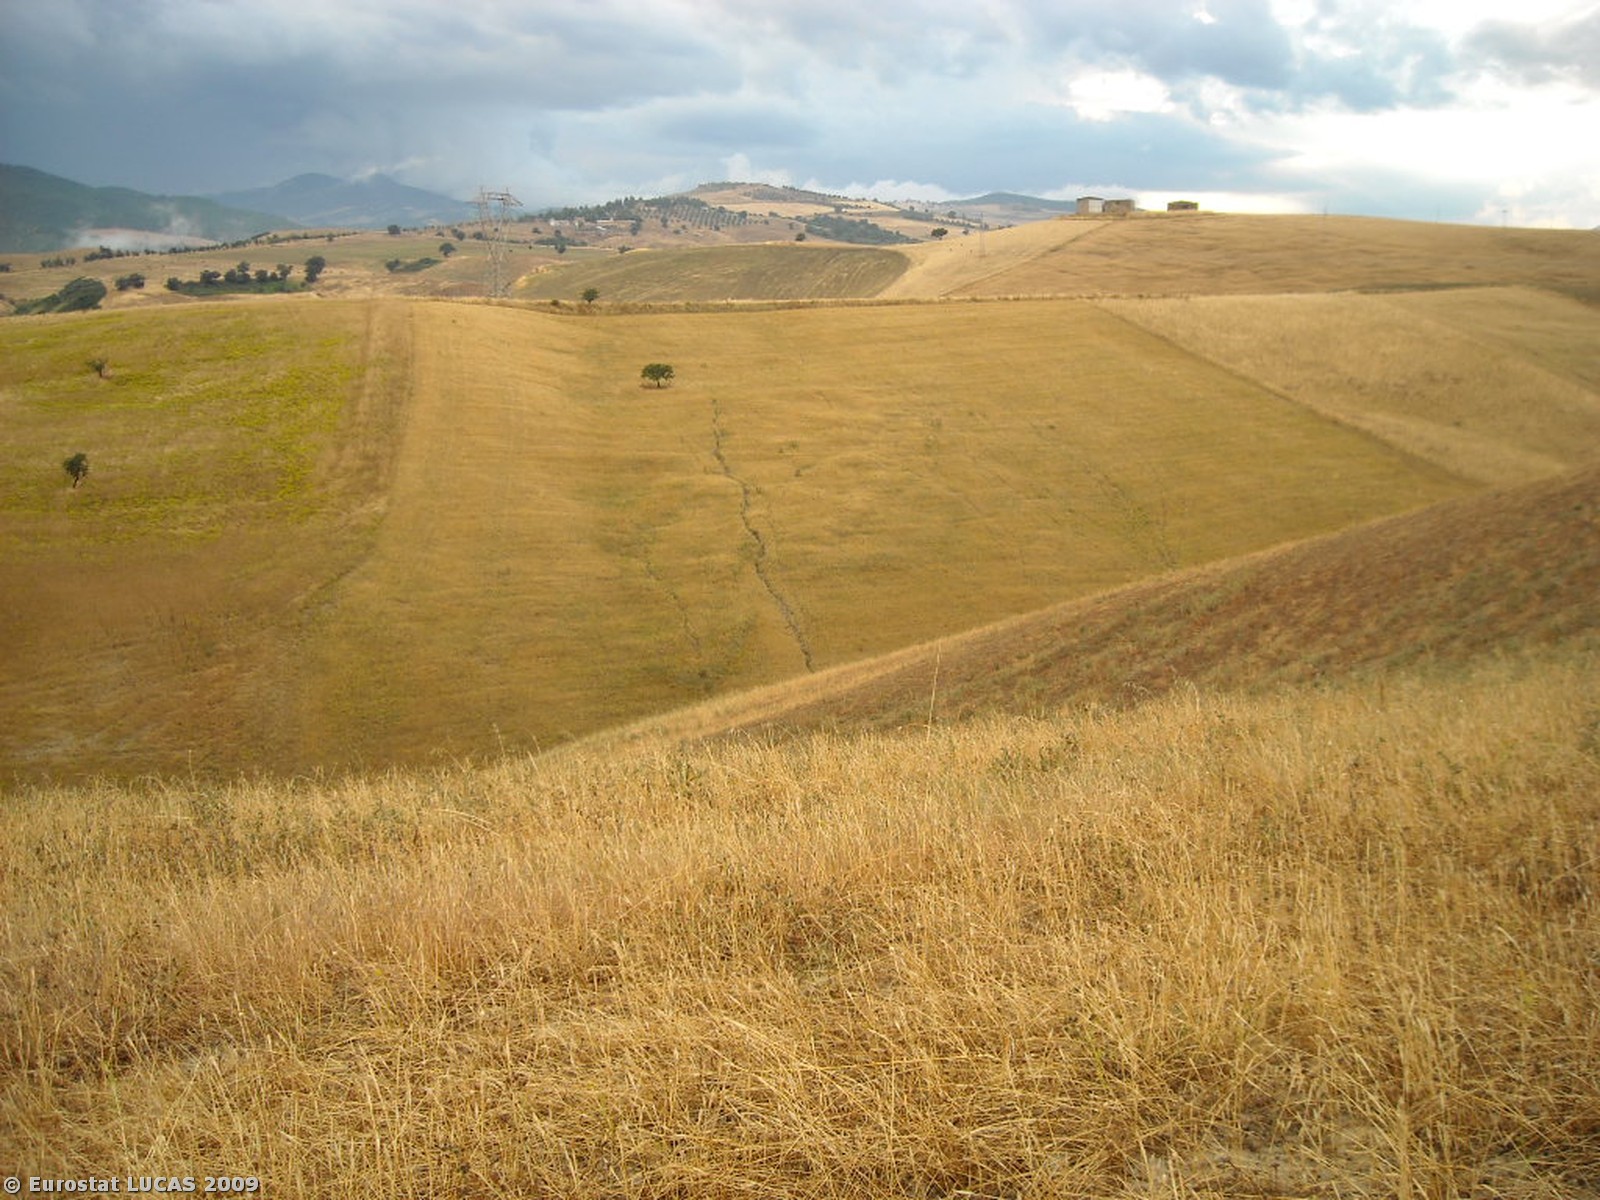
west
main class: Grassland
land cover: Spontaneously vegetated surfaces
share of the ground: > 75 %
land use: Fallow land
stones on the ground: < 10 %
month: June
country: IT
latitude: 40.5370
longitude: 16.2928
